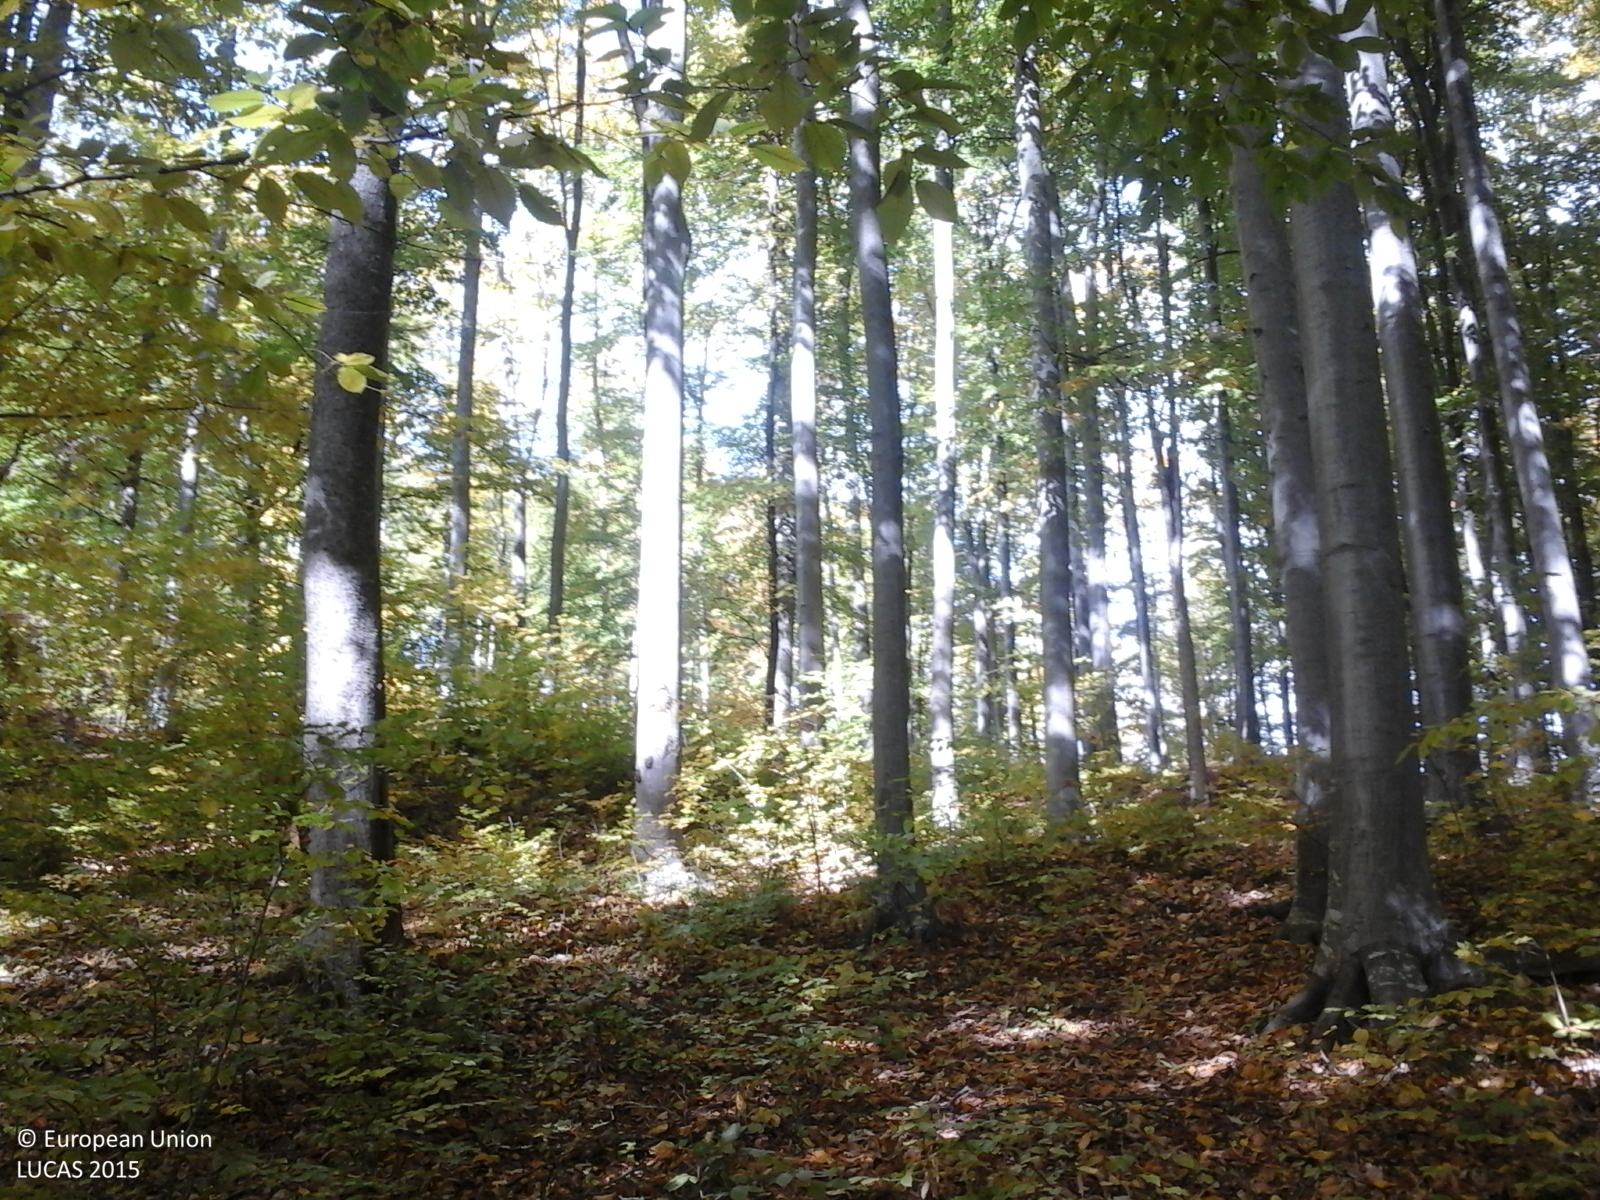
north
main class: Woodland
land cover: Broadleaved woodland
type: mesophytic deciduous forest
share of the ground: > 75 %
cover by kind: broadleaved forest trees 100 %
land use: Forestry
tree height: > 5 m
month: October
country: RO
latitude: 45.1976
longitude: 25.7227
